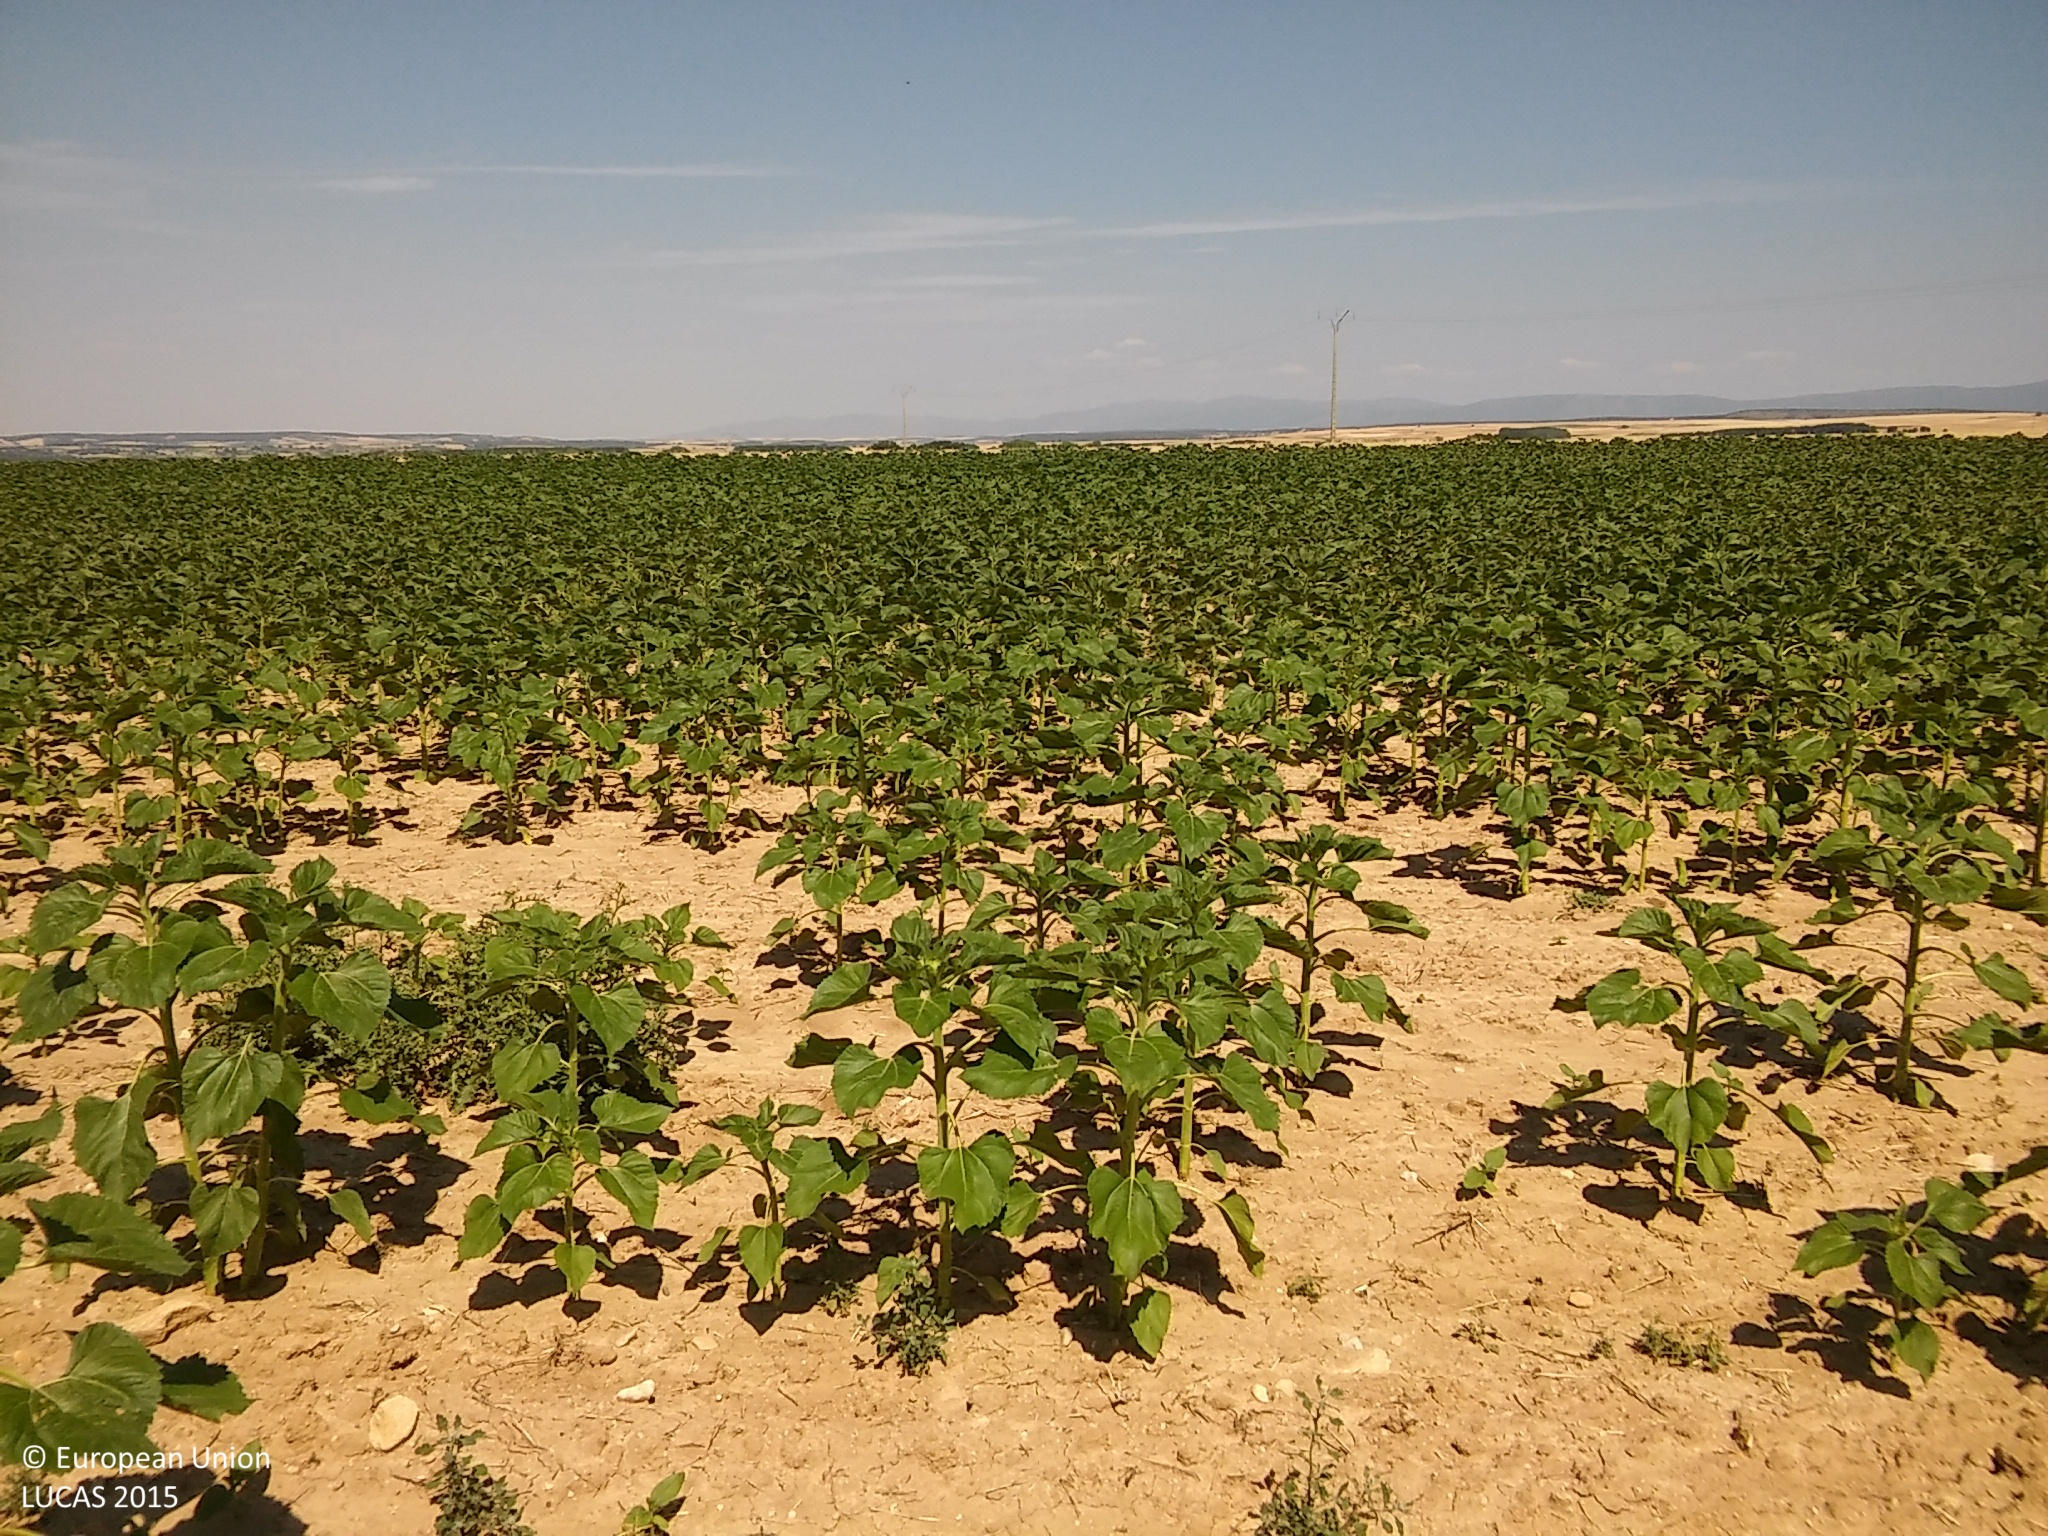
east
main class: Cropland
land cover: Sunflower
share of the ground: 25 - 50 %
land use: Agriculture (excluding fallow land and kitchen gardens)
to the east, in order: Sunflower; Common wheat; Barley; Electric lines; Barley
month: June
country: ES
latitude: 41.1660
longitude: -3.9837
